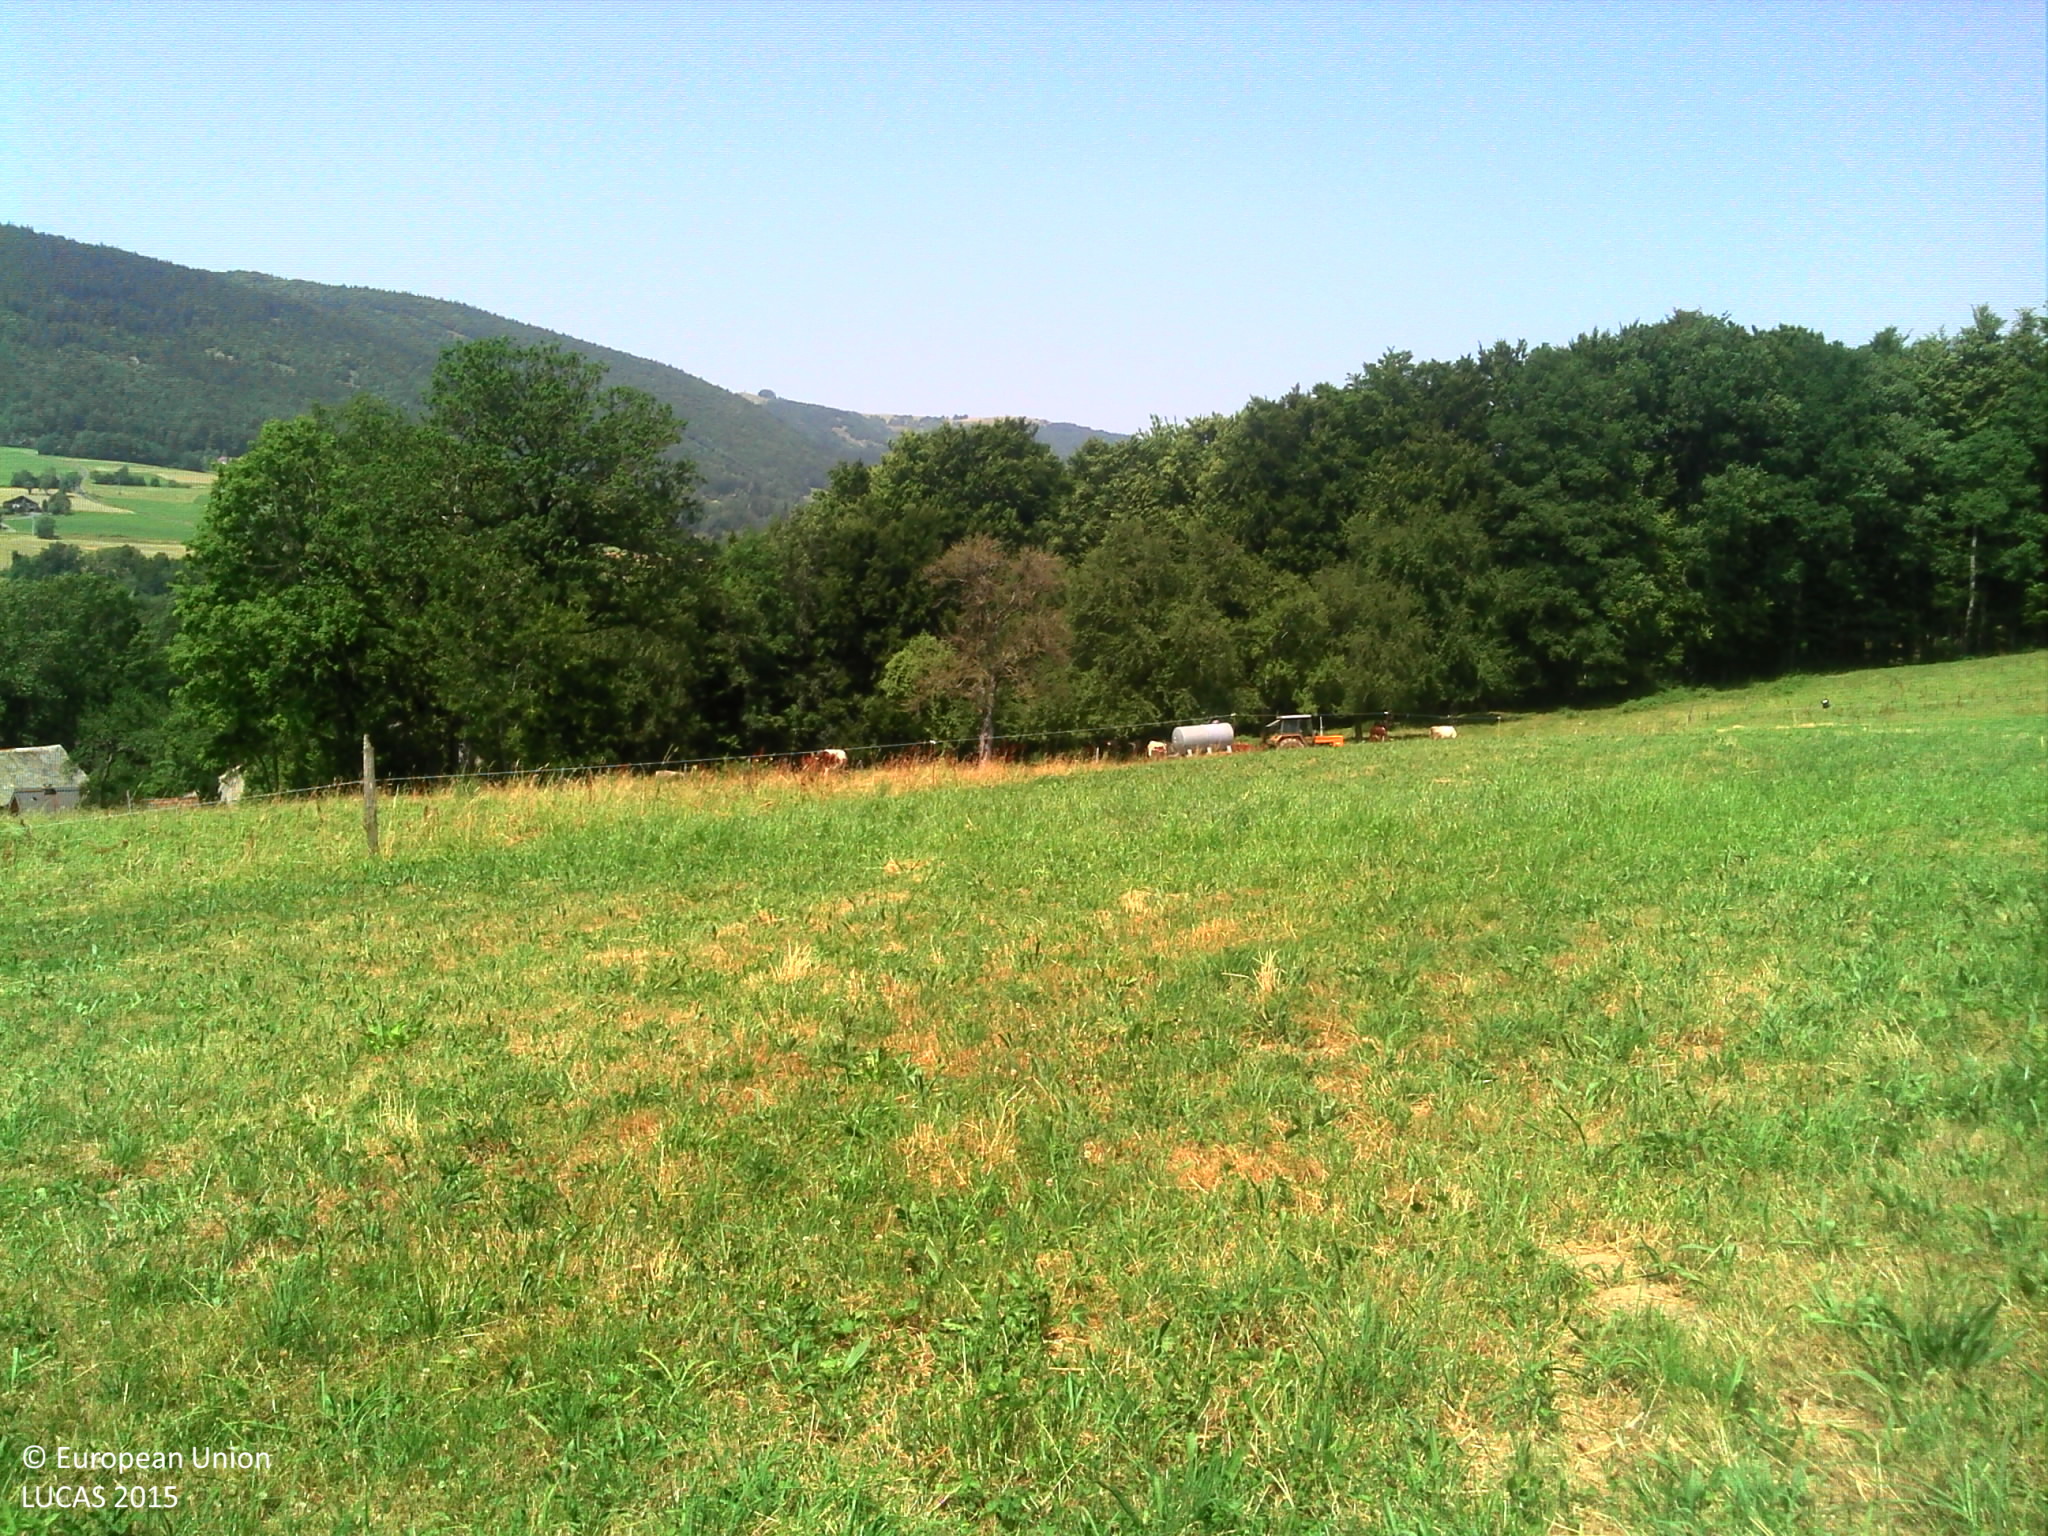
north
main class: Grassland
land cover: Grassland without tree/shrub cover
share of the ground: > 75 %
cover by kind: herbaceous plants 100 %
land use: Agriculture (excluding fallow land and kitchen gardens)
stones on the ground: < 10 %
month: July
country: FR
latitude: 46.0850
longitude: 6.1886
